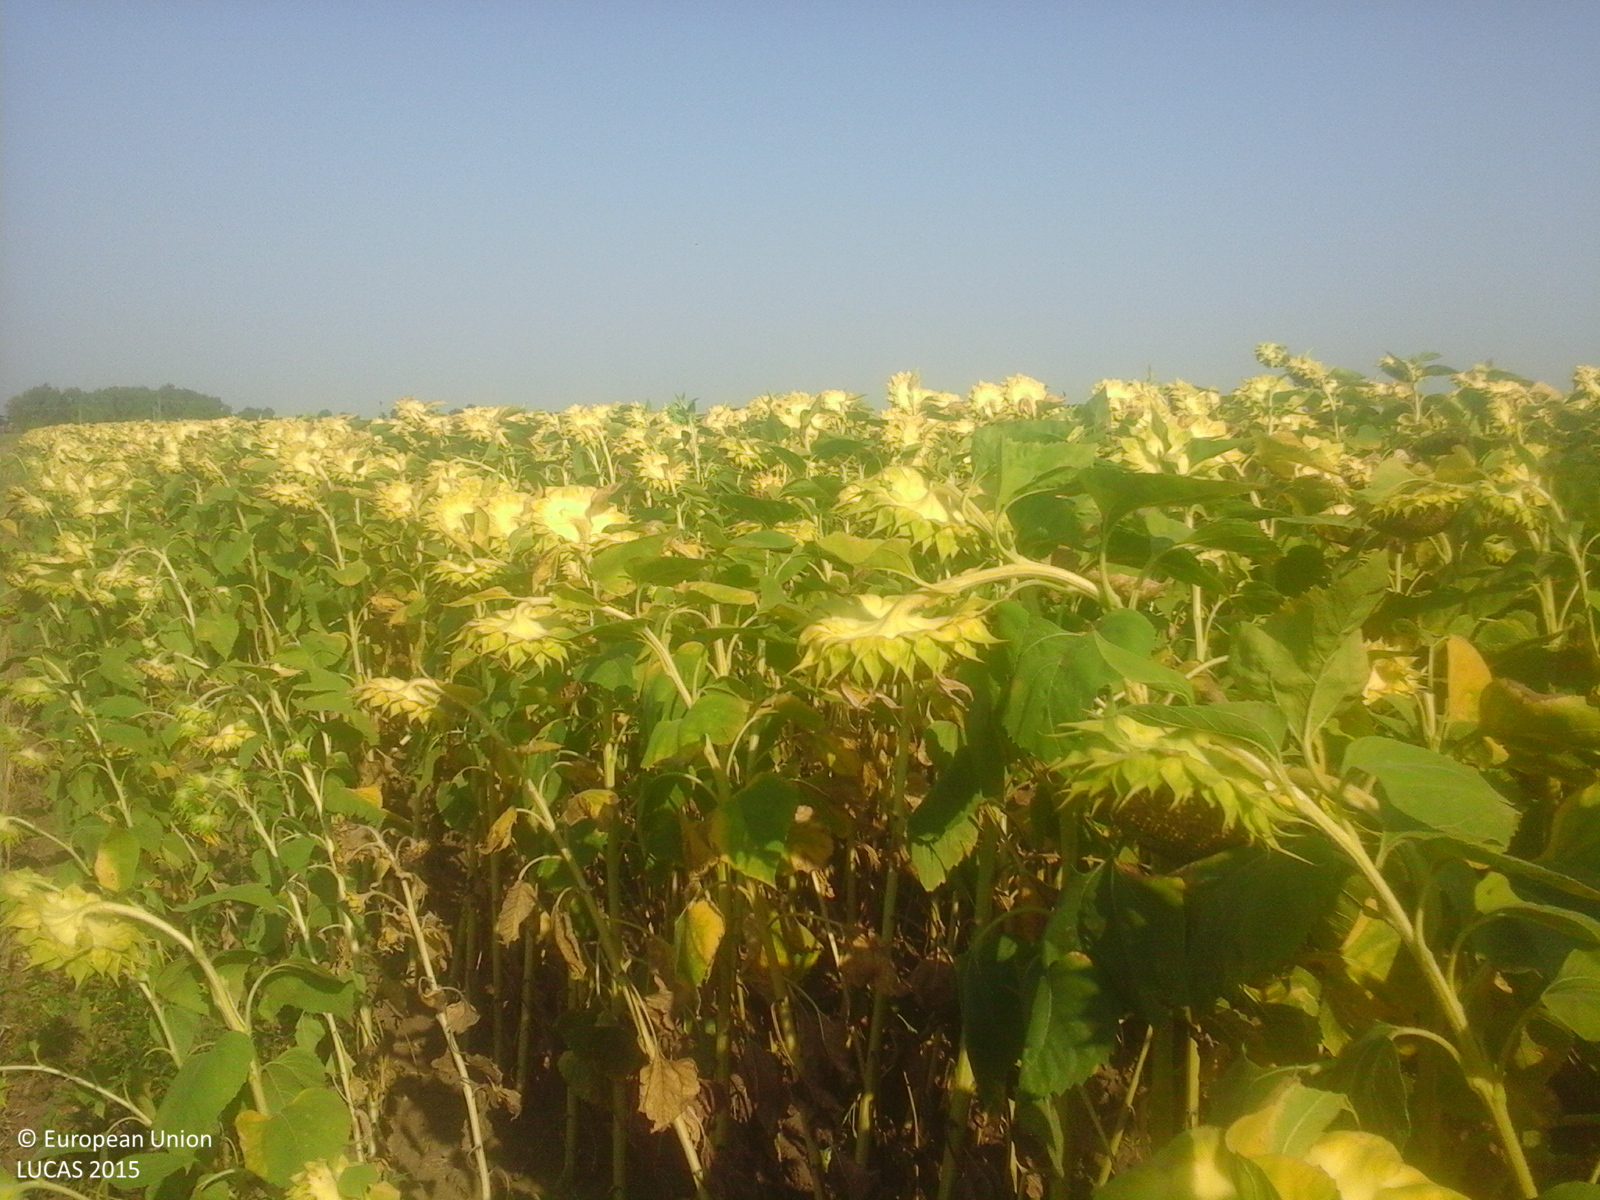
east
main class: Cropland
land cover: Sunflower
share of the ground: > 75 %
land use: Agriculture (excluding fallow land and kitchen gardens)
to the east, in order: Sunflower; Lucerne; Maize; Lucerne
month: August
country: RO
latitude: 45.2159
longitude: 27.6645
